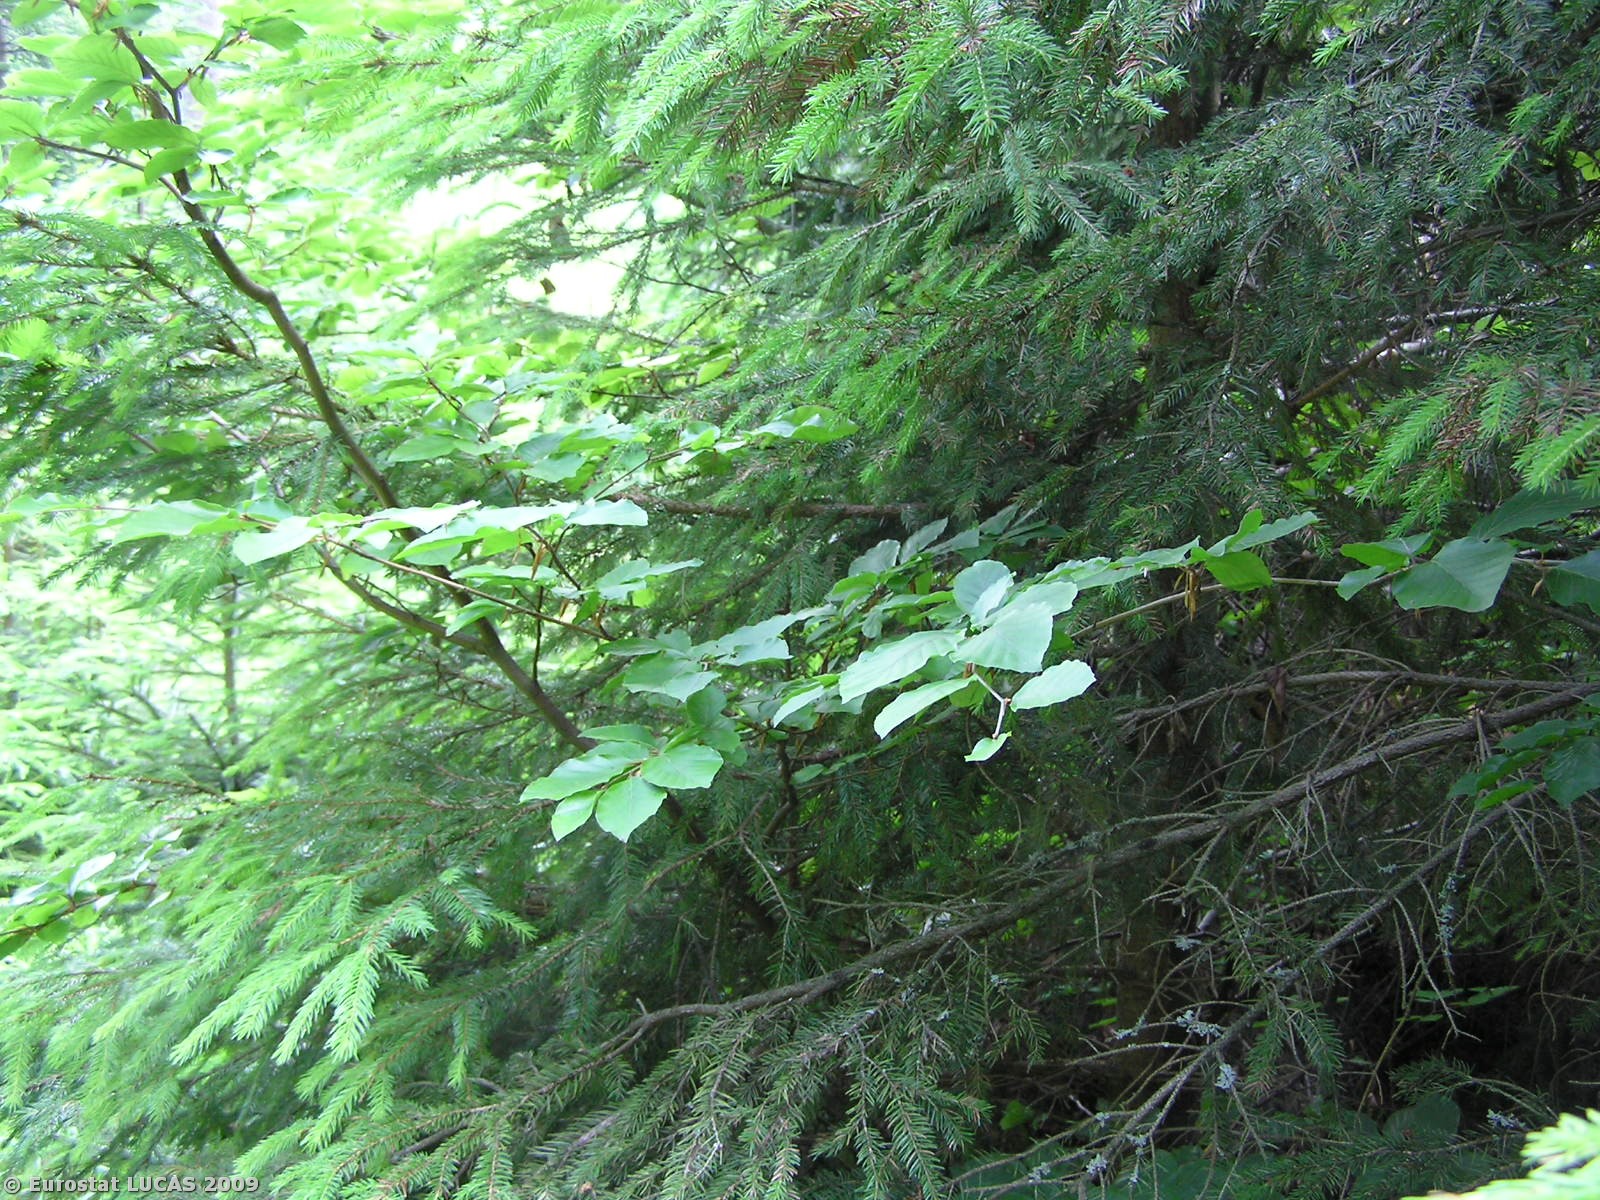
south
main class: Woodland
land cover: Coniferous woodland
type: hemiboreal forest and nemoral coniferous forest and mixed broadleaved-coniferous forest
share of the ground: > 75 %
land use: Forestry
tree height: > 5 m
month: July
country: CZ
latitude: 50.1001
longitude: 17.4919
